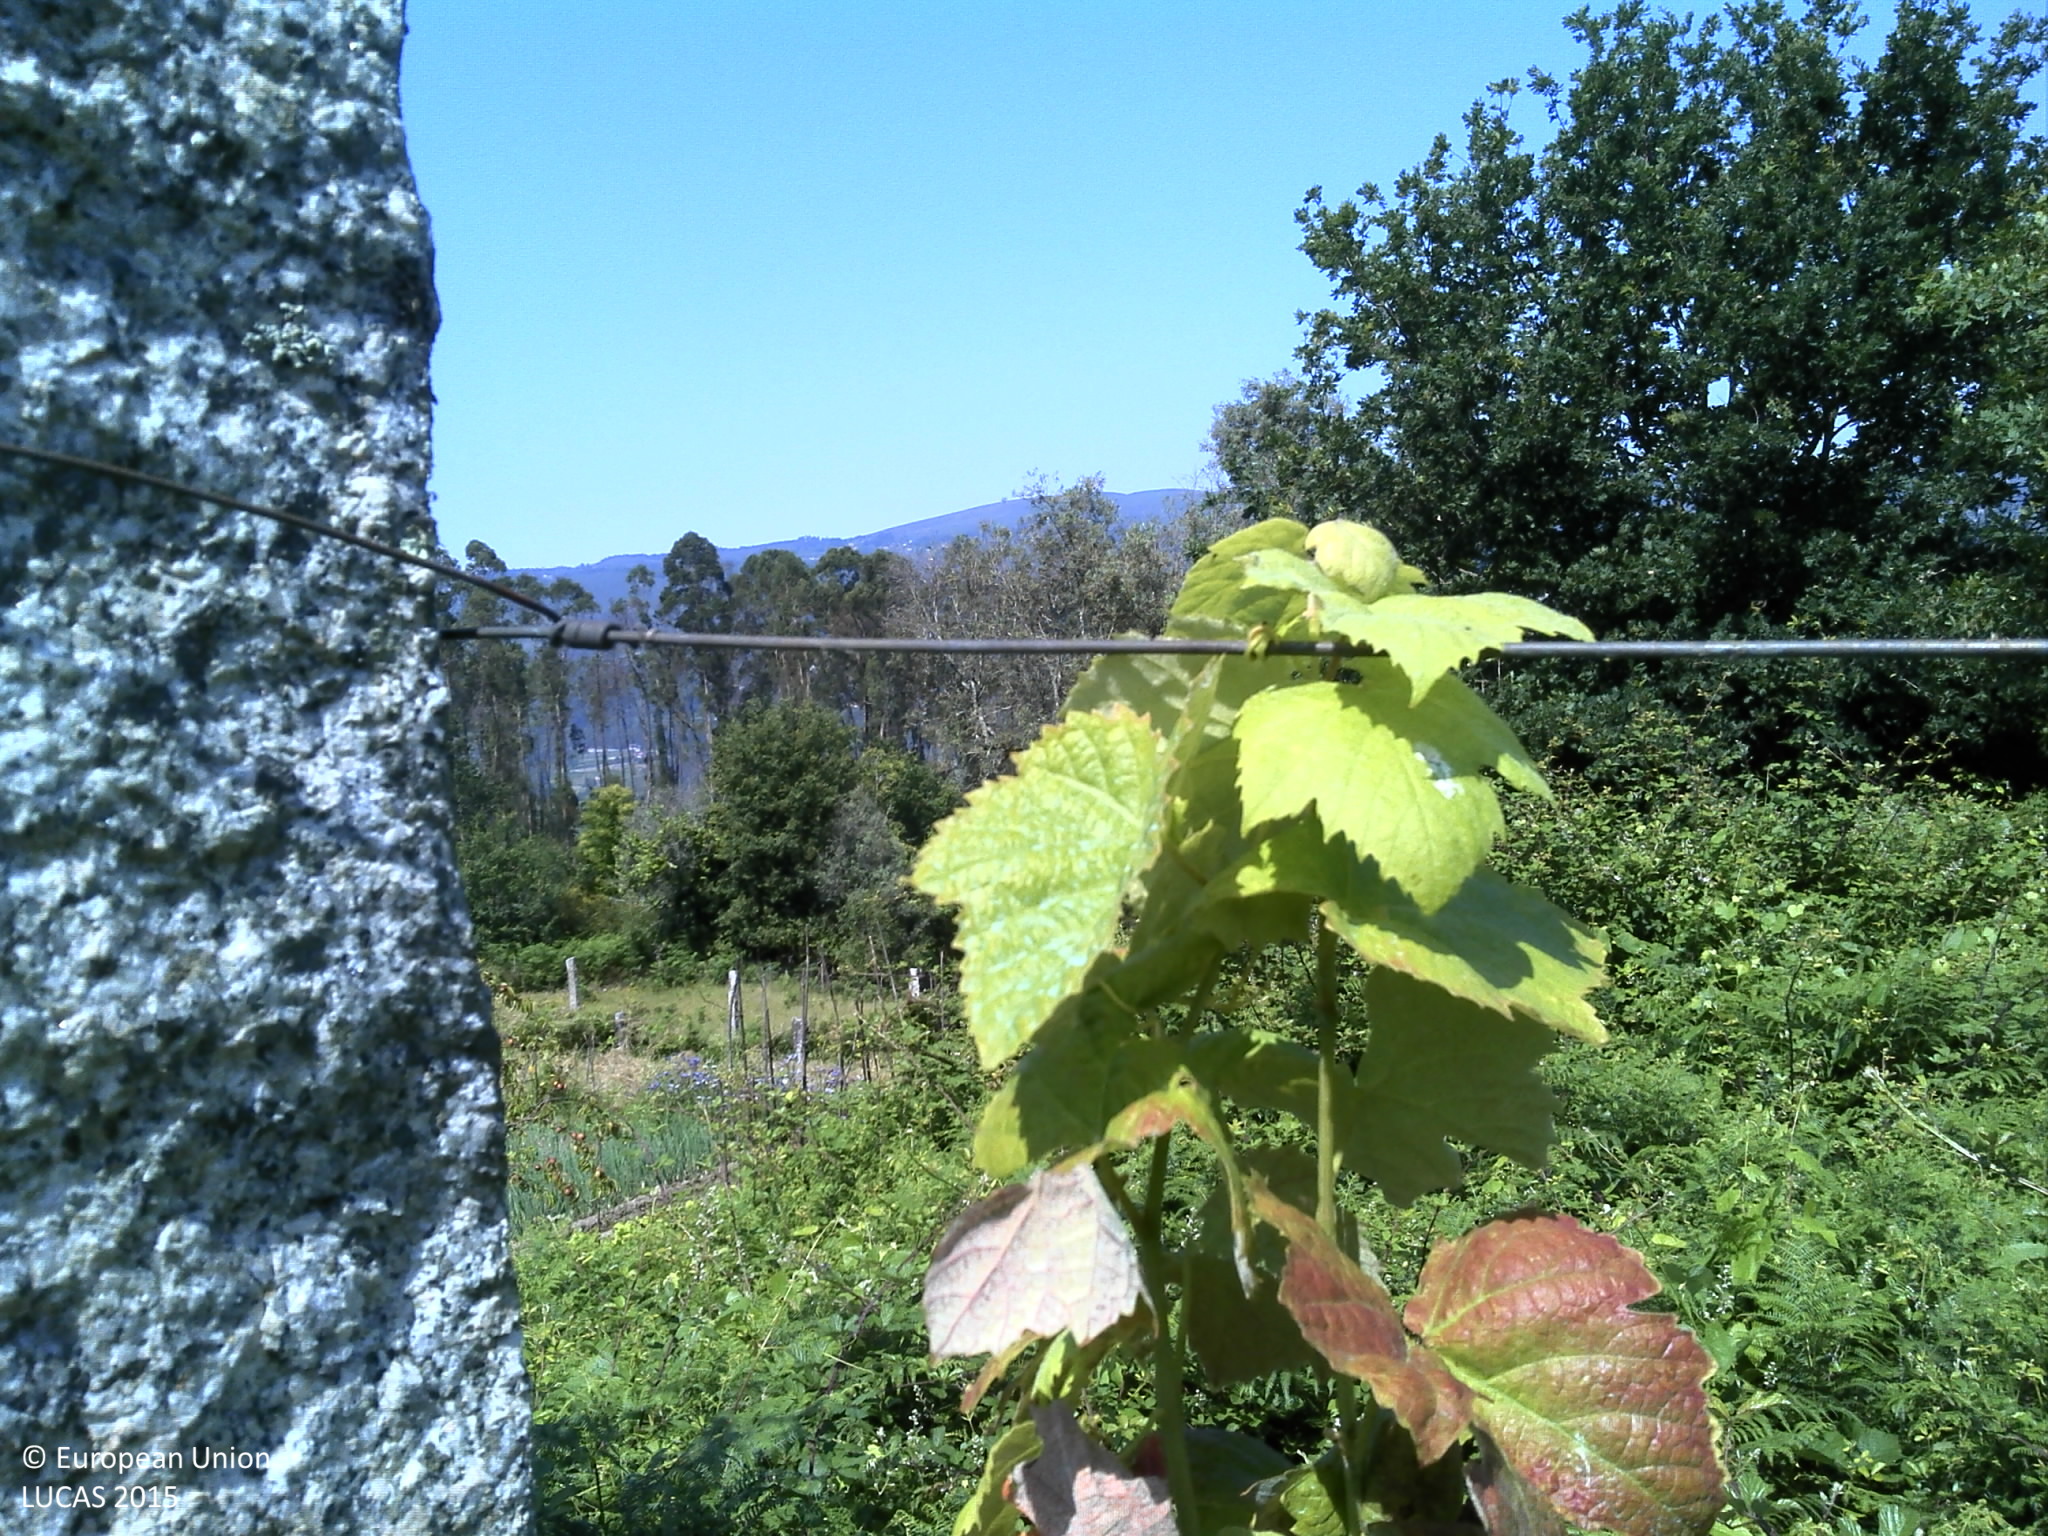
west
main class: Shrubland
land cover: Shrubland with sparse tree cover
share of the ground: > 75 %
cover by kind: shrubs 85 %, herbaceous plants 10 %, broadleaved forest trees 5 %
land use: Abandoned areas
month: June
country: PT
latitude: 41.9249
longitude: -8.4288
